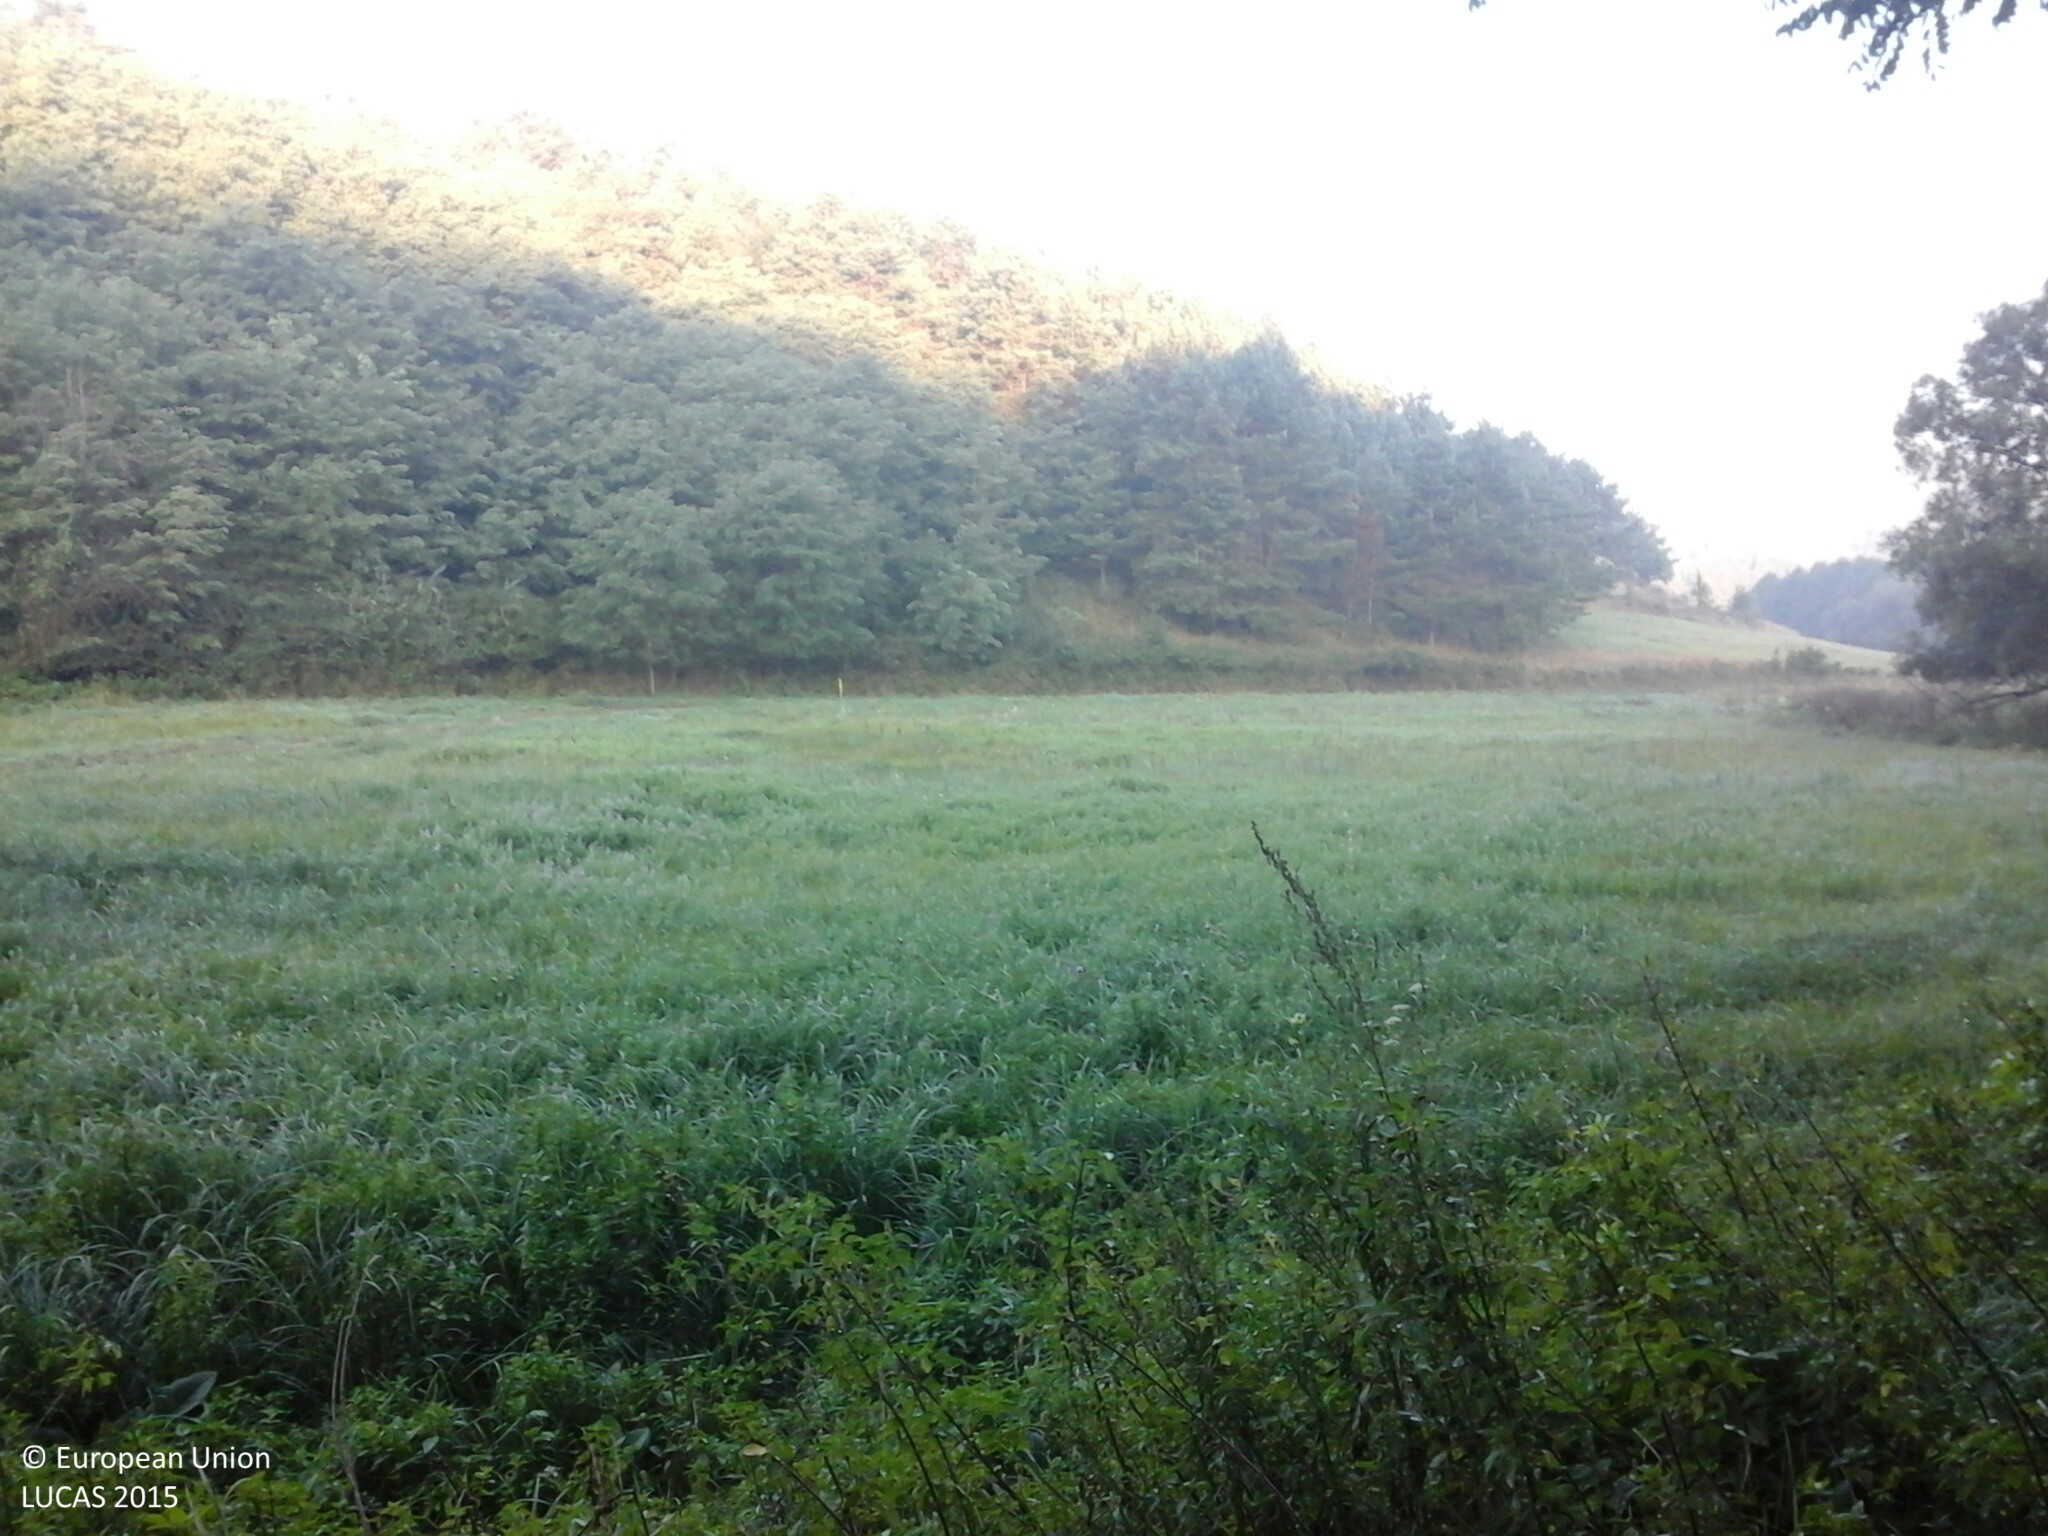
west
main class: Woodland
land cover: Broadleaved woodland
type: mesophytic deciduous forest
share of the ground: > 75 %
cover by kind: broadleaved forest trees 90 %, herbaceous plants 10 %
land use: Forestry
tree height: > 5 m
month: September
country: HU
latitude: 48.1422
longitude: 20.0684
